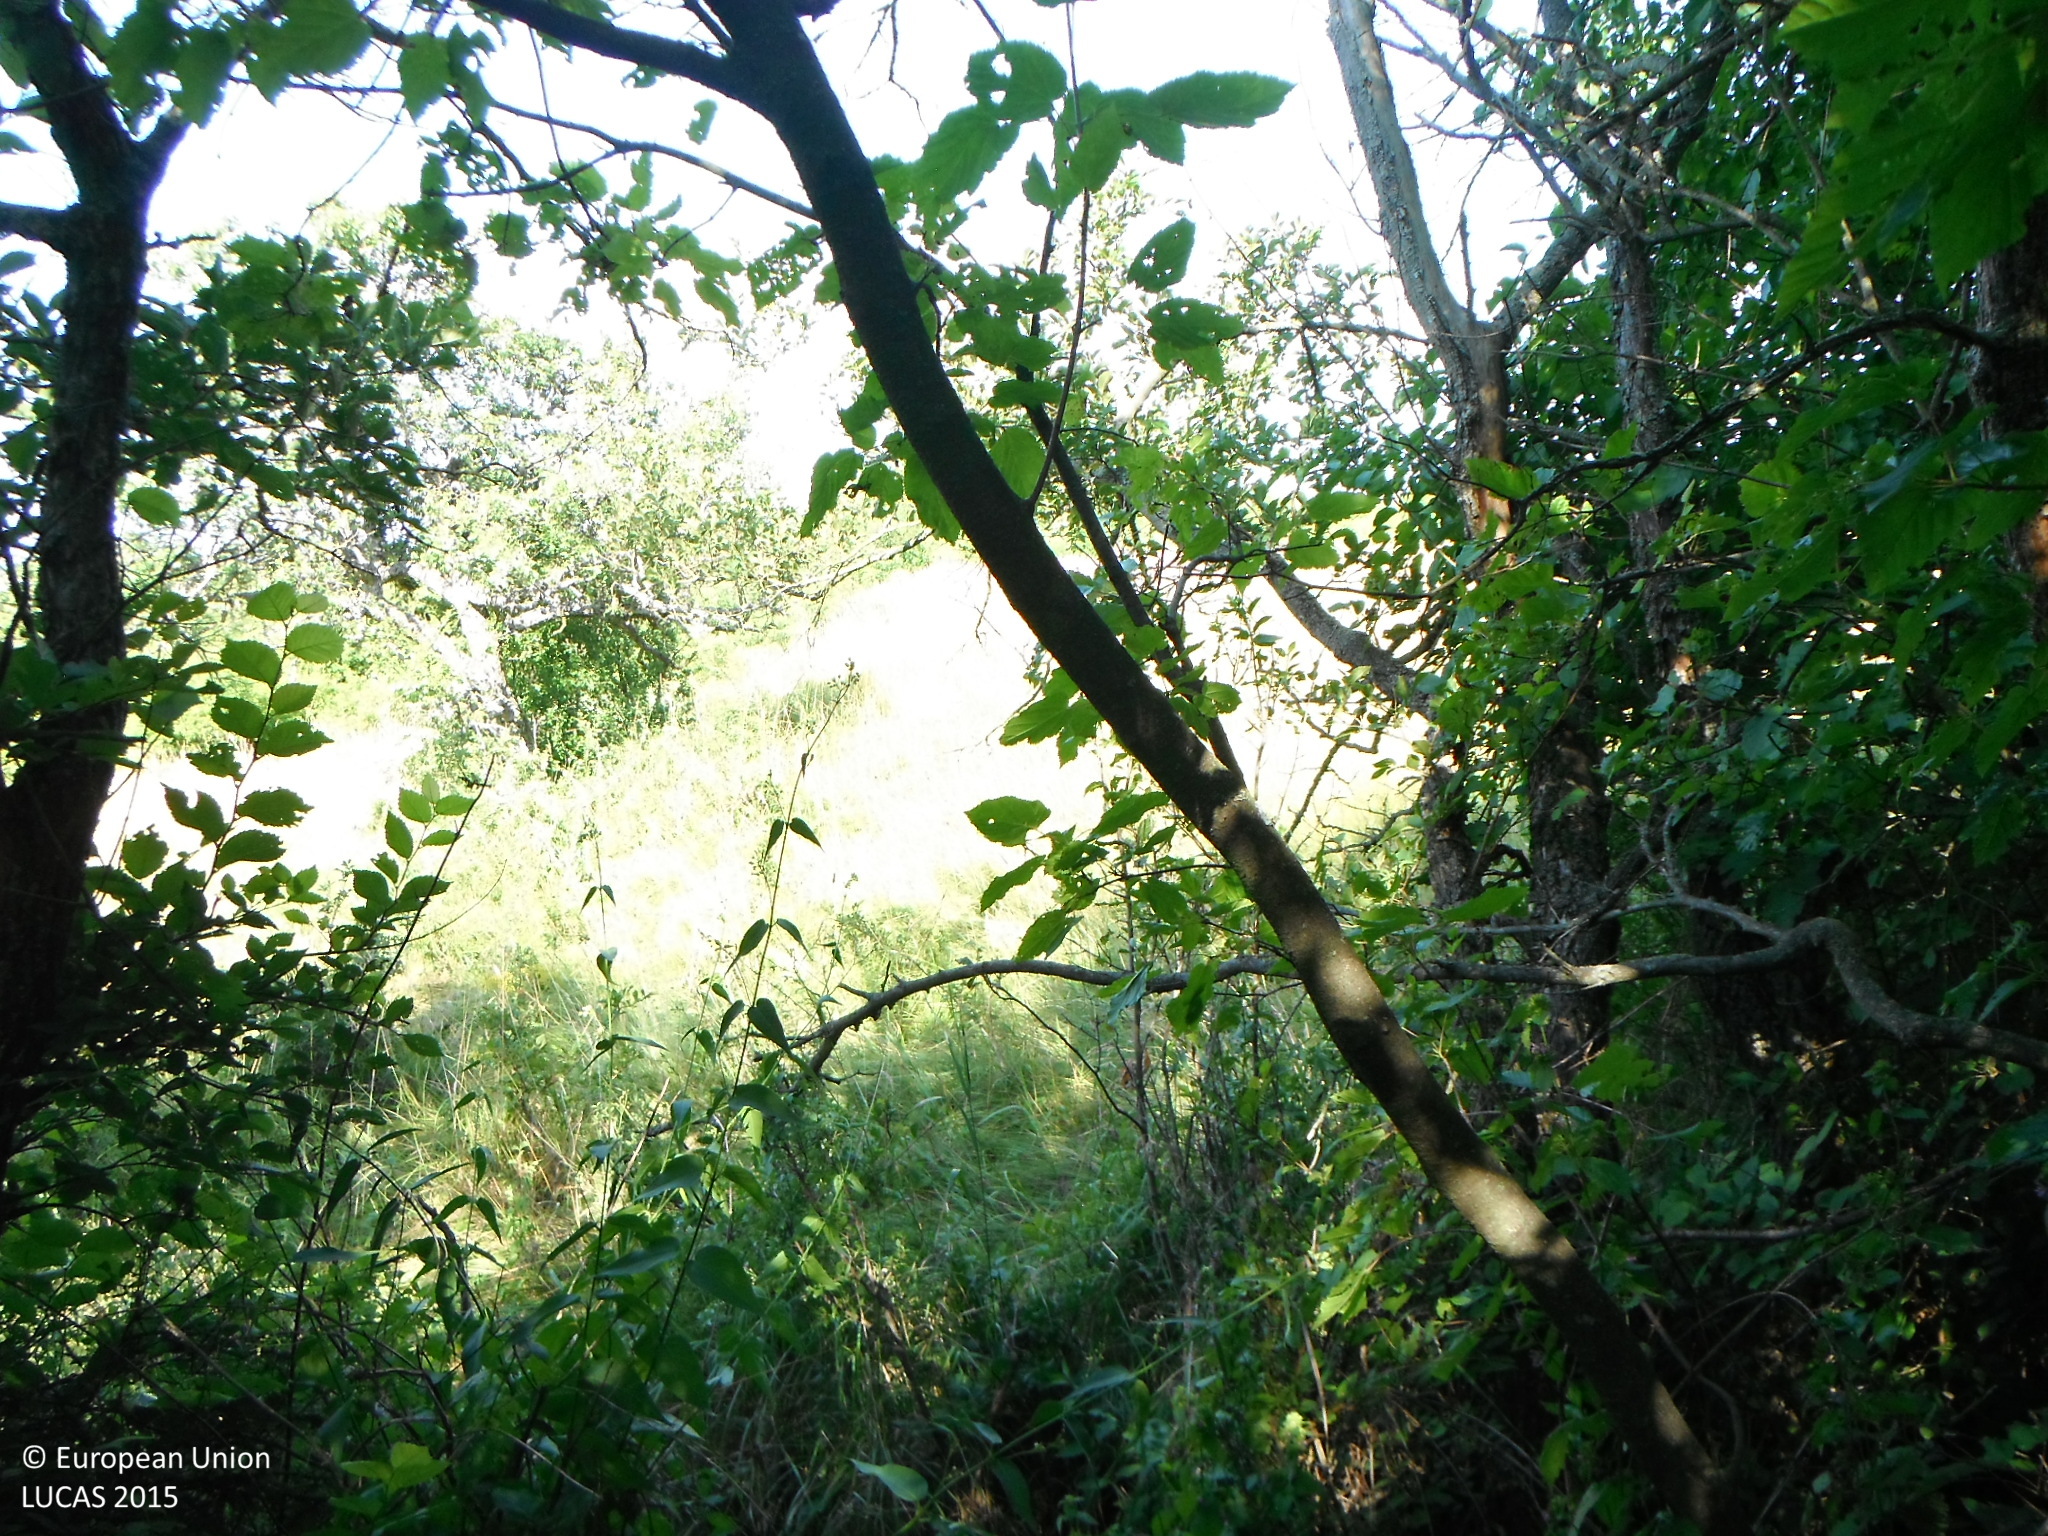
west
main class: Shrubland
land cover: Shrubland with sparse tree cover
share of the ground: > 75 %
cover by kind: shrubs 95 %, broadleaved forest trees 5 %
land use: Semi-natural and natural areas not in use
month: June
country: SK
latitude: 48.2058
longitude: 18.9136
